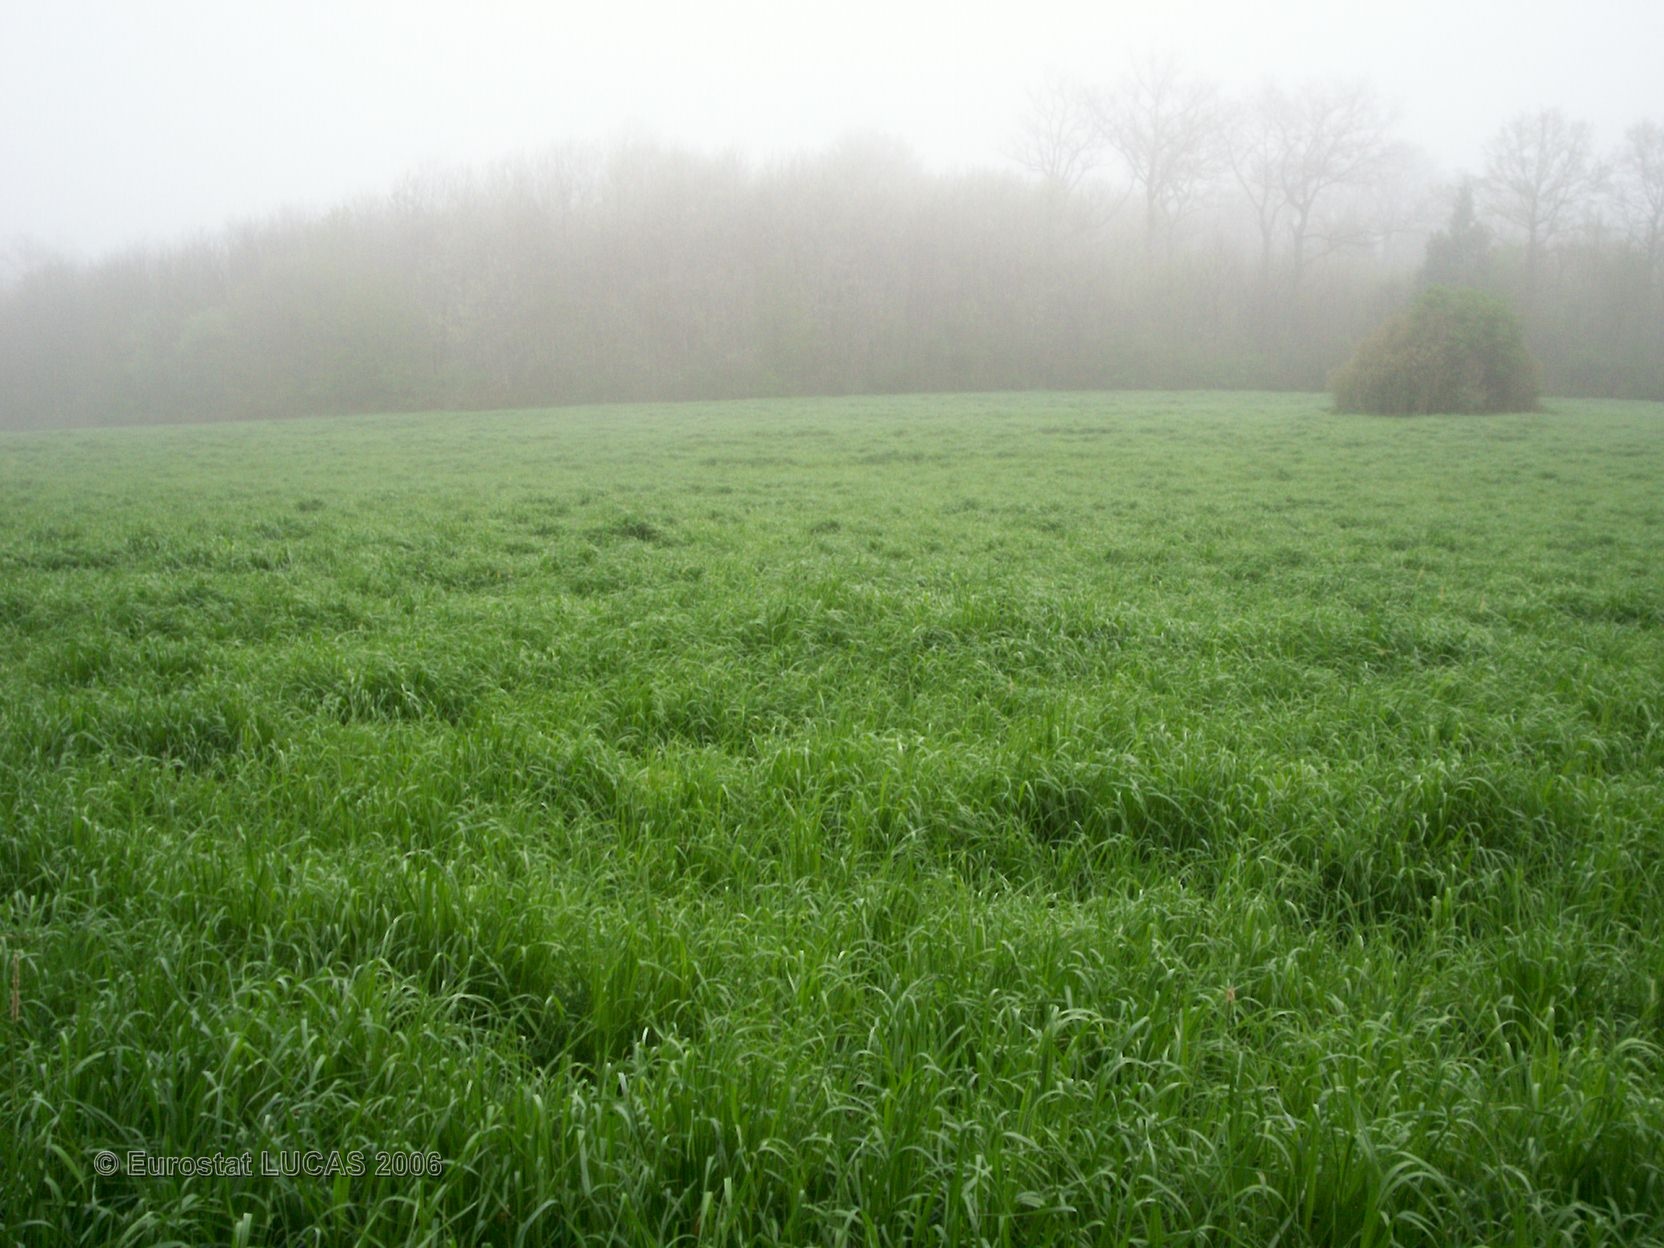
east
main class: Grassland
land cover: Grassland without tree/shrub cover
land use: Agriculture (excluding fallow land and kitchen gardens)
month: April
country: FR
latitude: 45.4639
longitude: 0.5876
